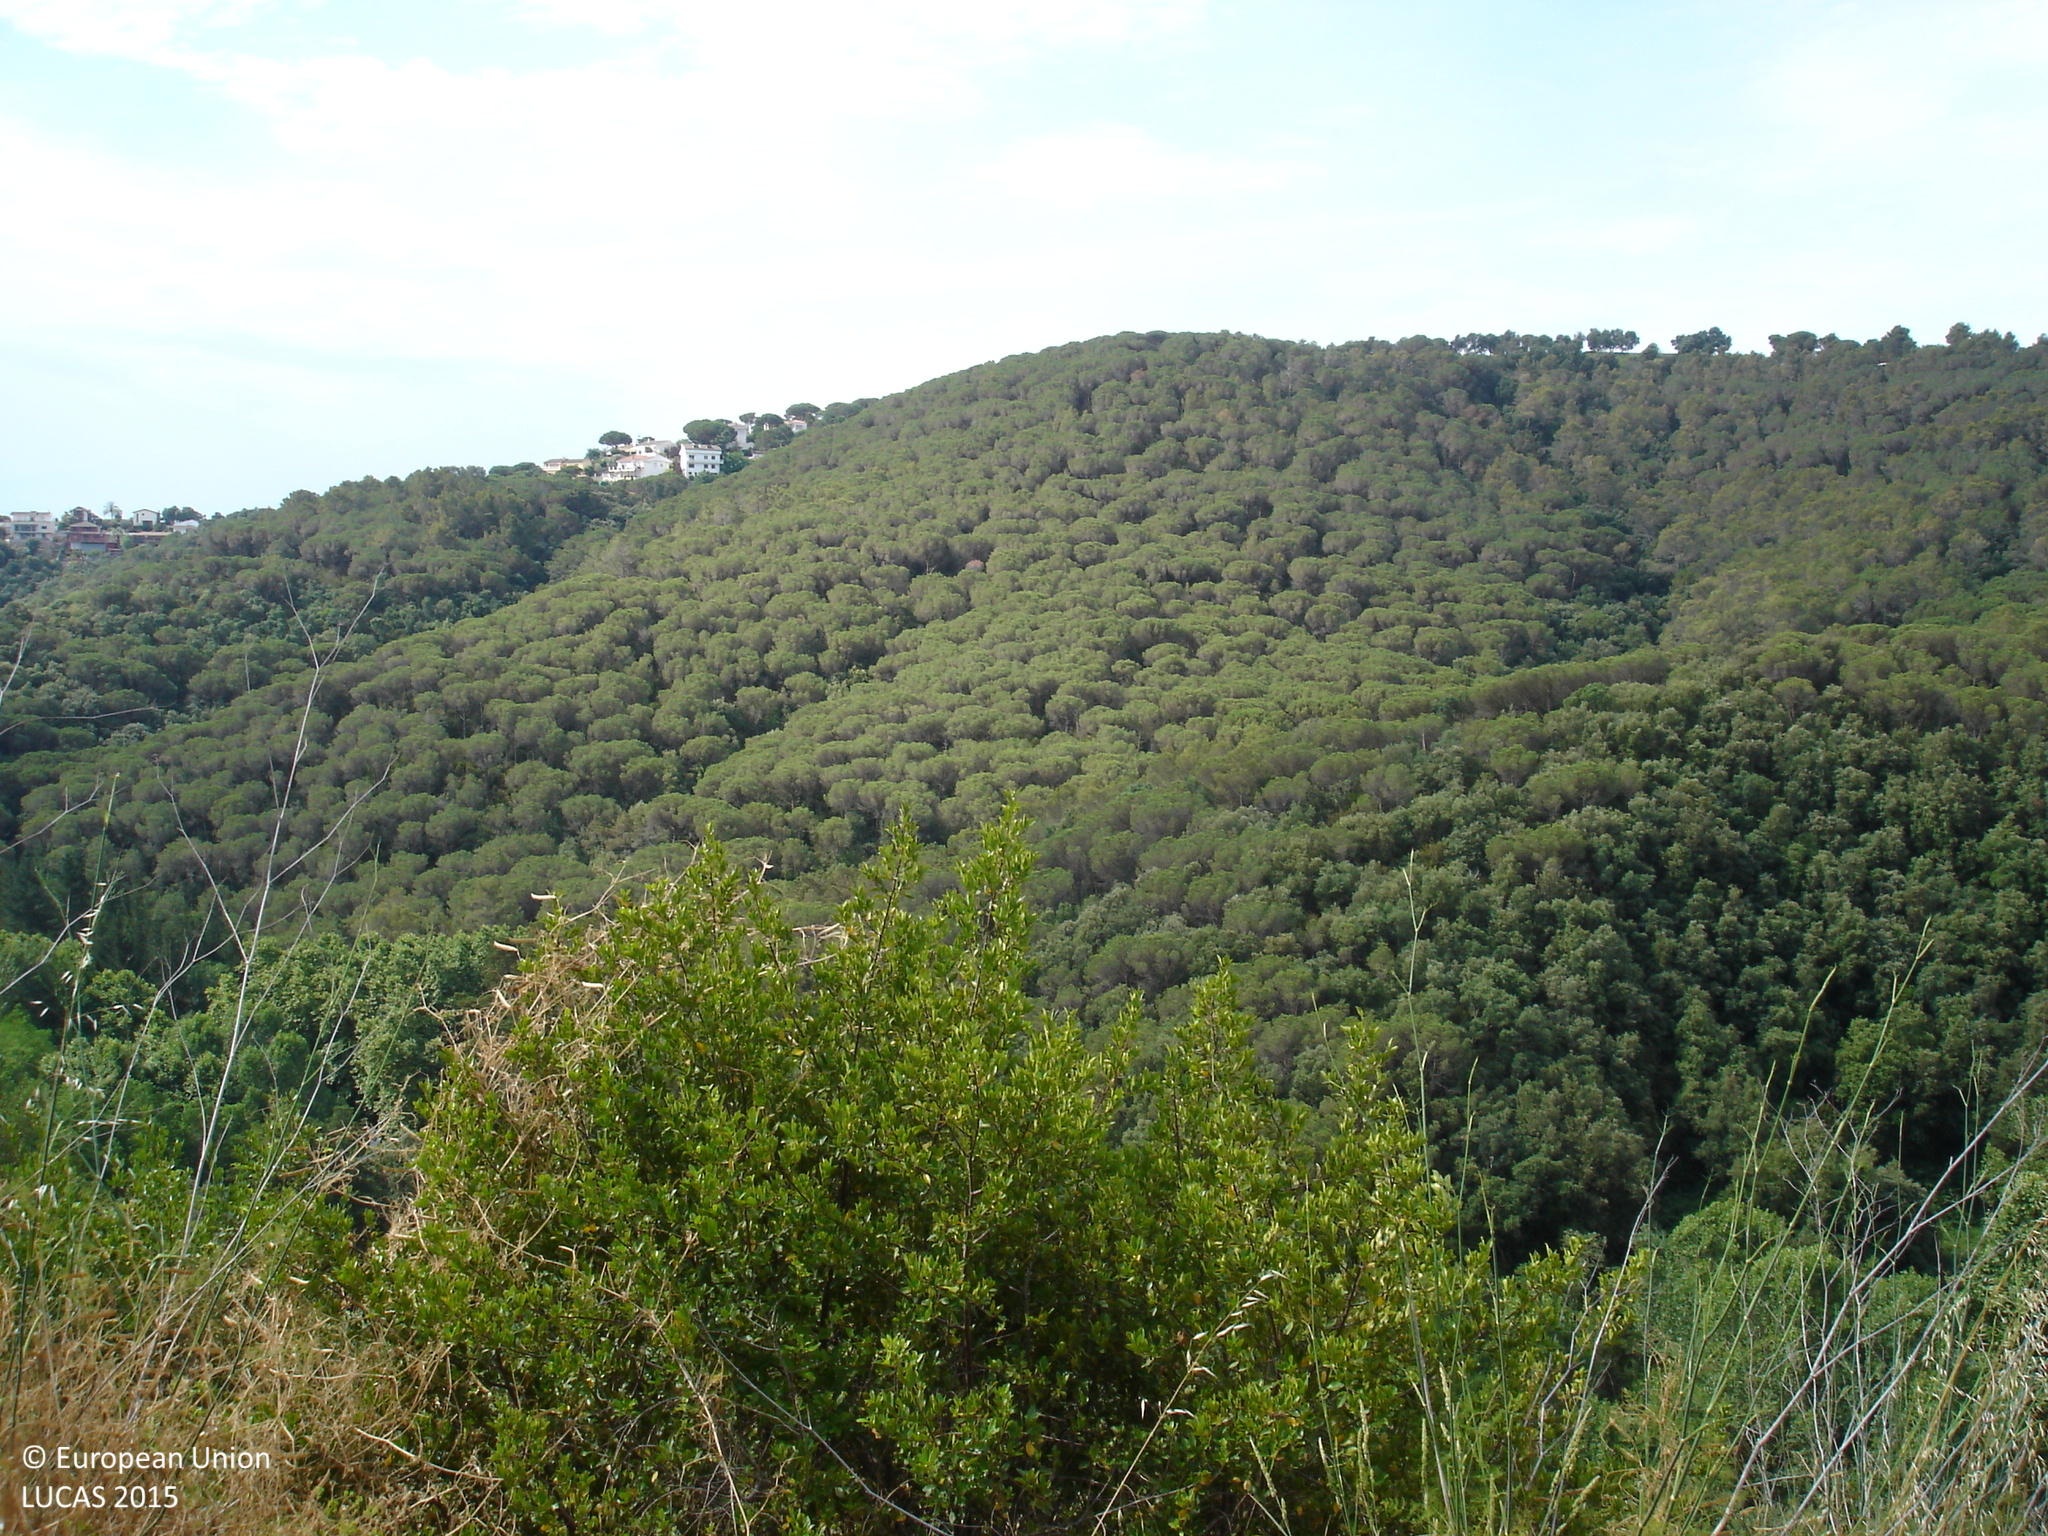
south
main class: Woodland
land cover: Pine dominated mixed woodland
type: coniferous forest of the mediterranean region
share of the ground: 50 - 75 %
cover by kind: coniferous forest trees 45 %, herbaceous plants 25 %, broadleaved forest trees 15 %, consolidated bare surface 10 %, shrubs 5 %
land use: Forestry
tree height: > 5 m
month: June
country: ES
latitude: 41.6206
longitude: 2.5882
